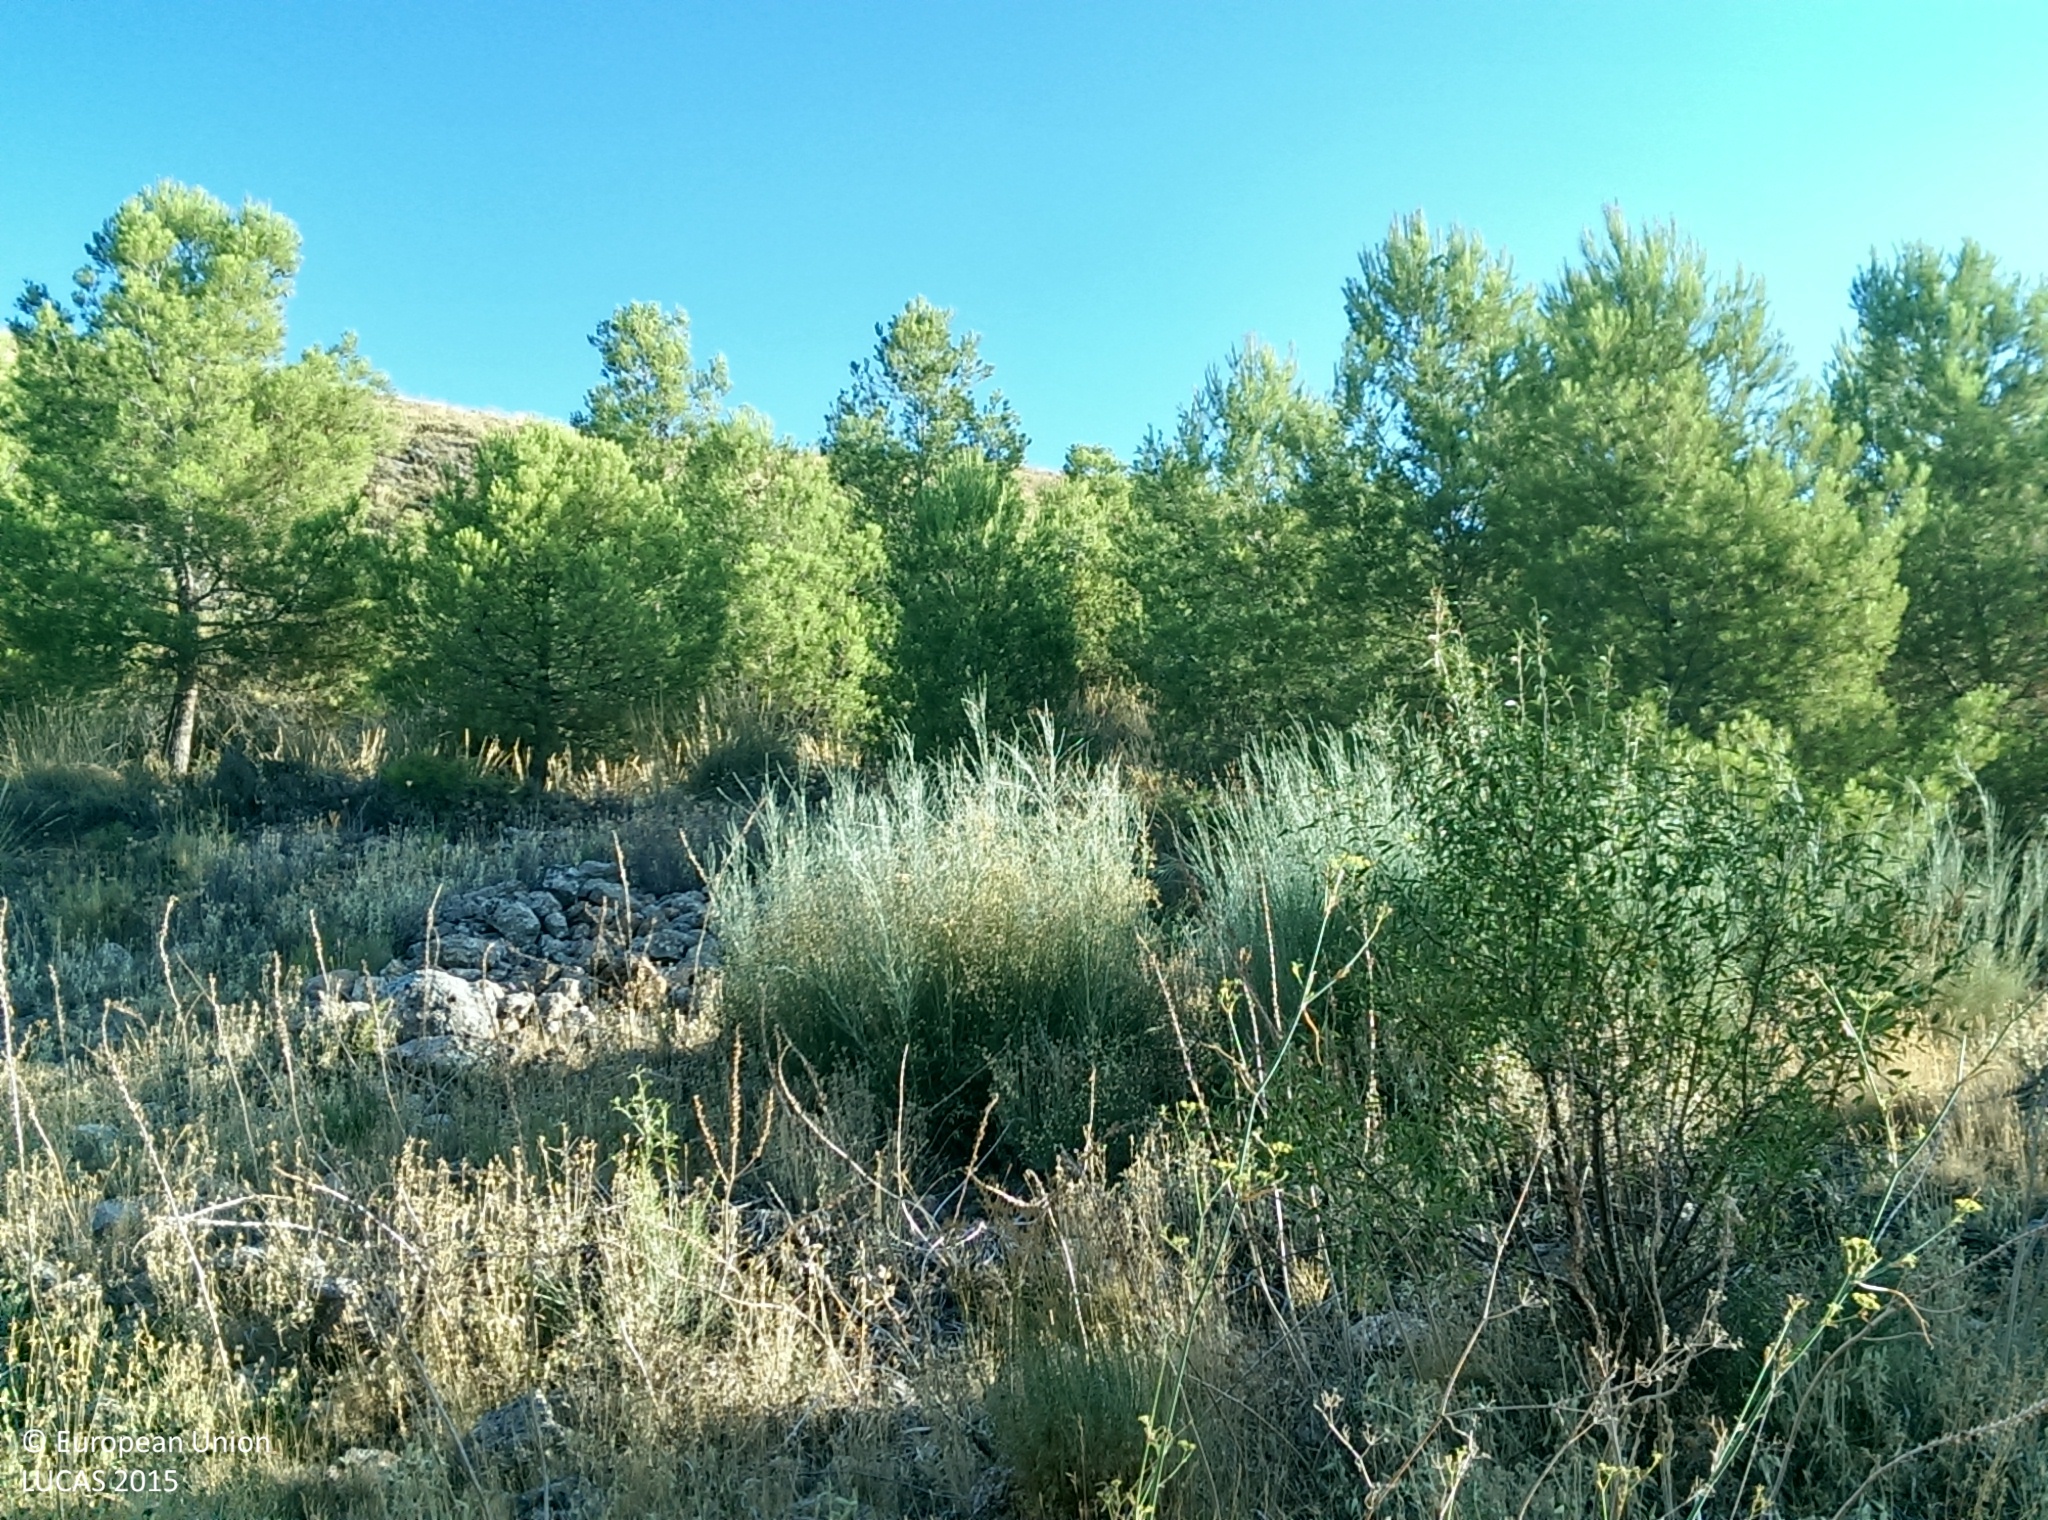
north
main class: Shrubland
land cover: Shrubland without tree cover
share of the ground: > 75 %
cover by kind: shrubs 75 %, herbaceous plants 15 %, consolidated bare surface 5 %, unconsolidated bare surface 5 %
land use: Semi-natural and natural areas not in use
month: August
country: ES
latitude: 36.9072
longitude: -3.1234
